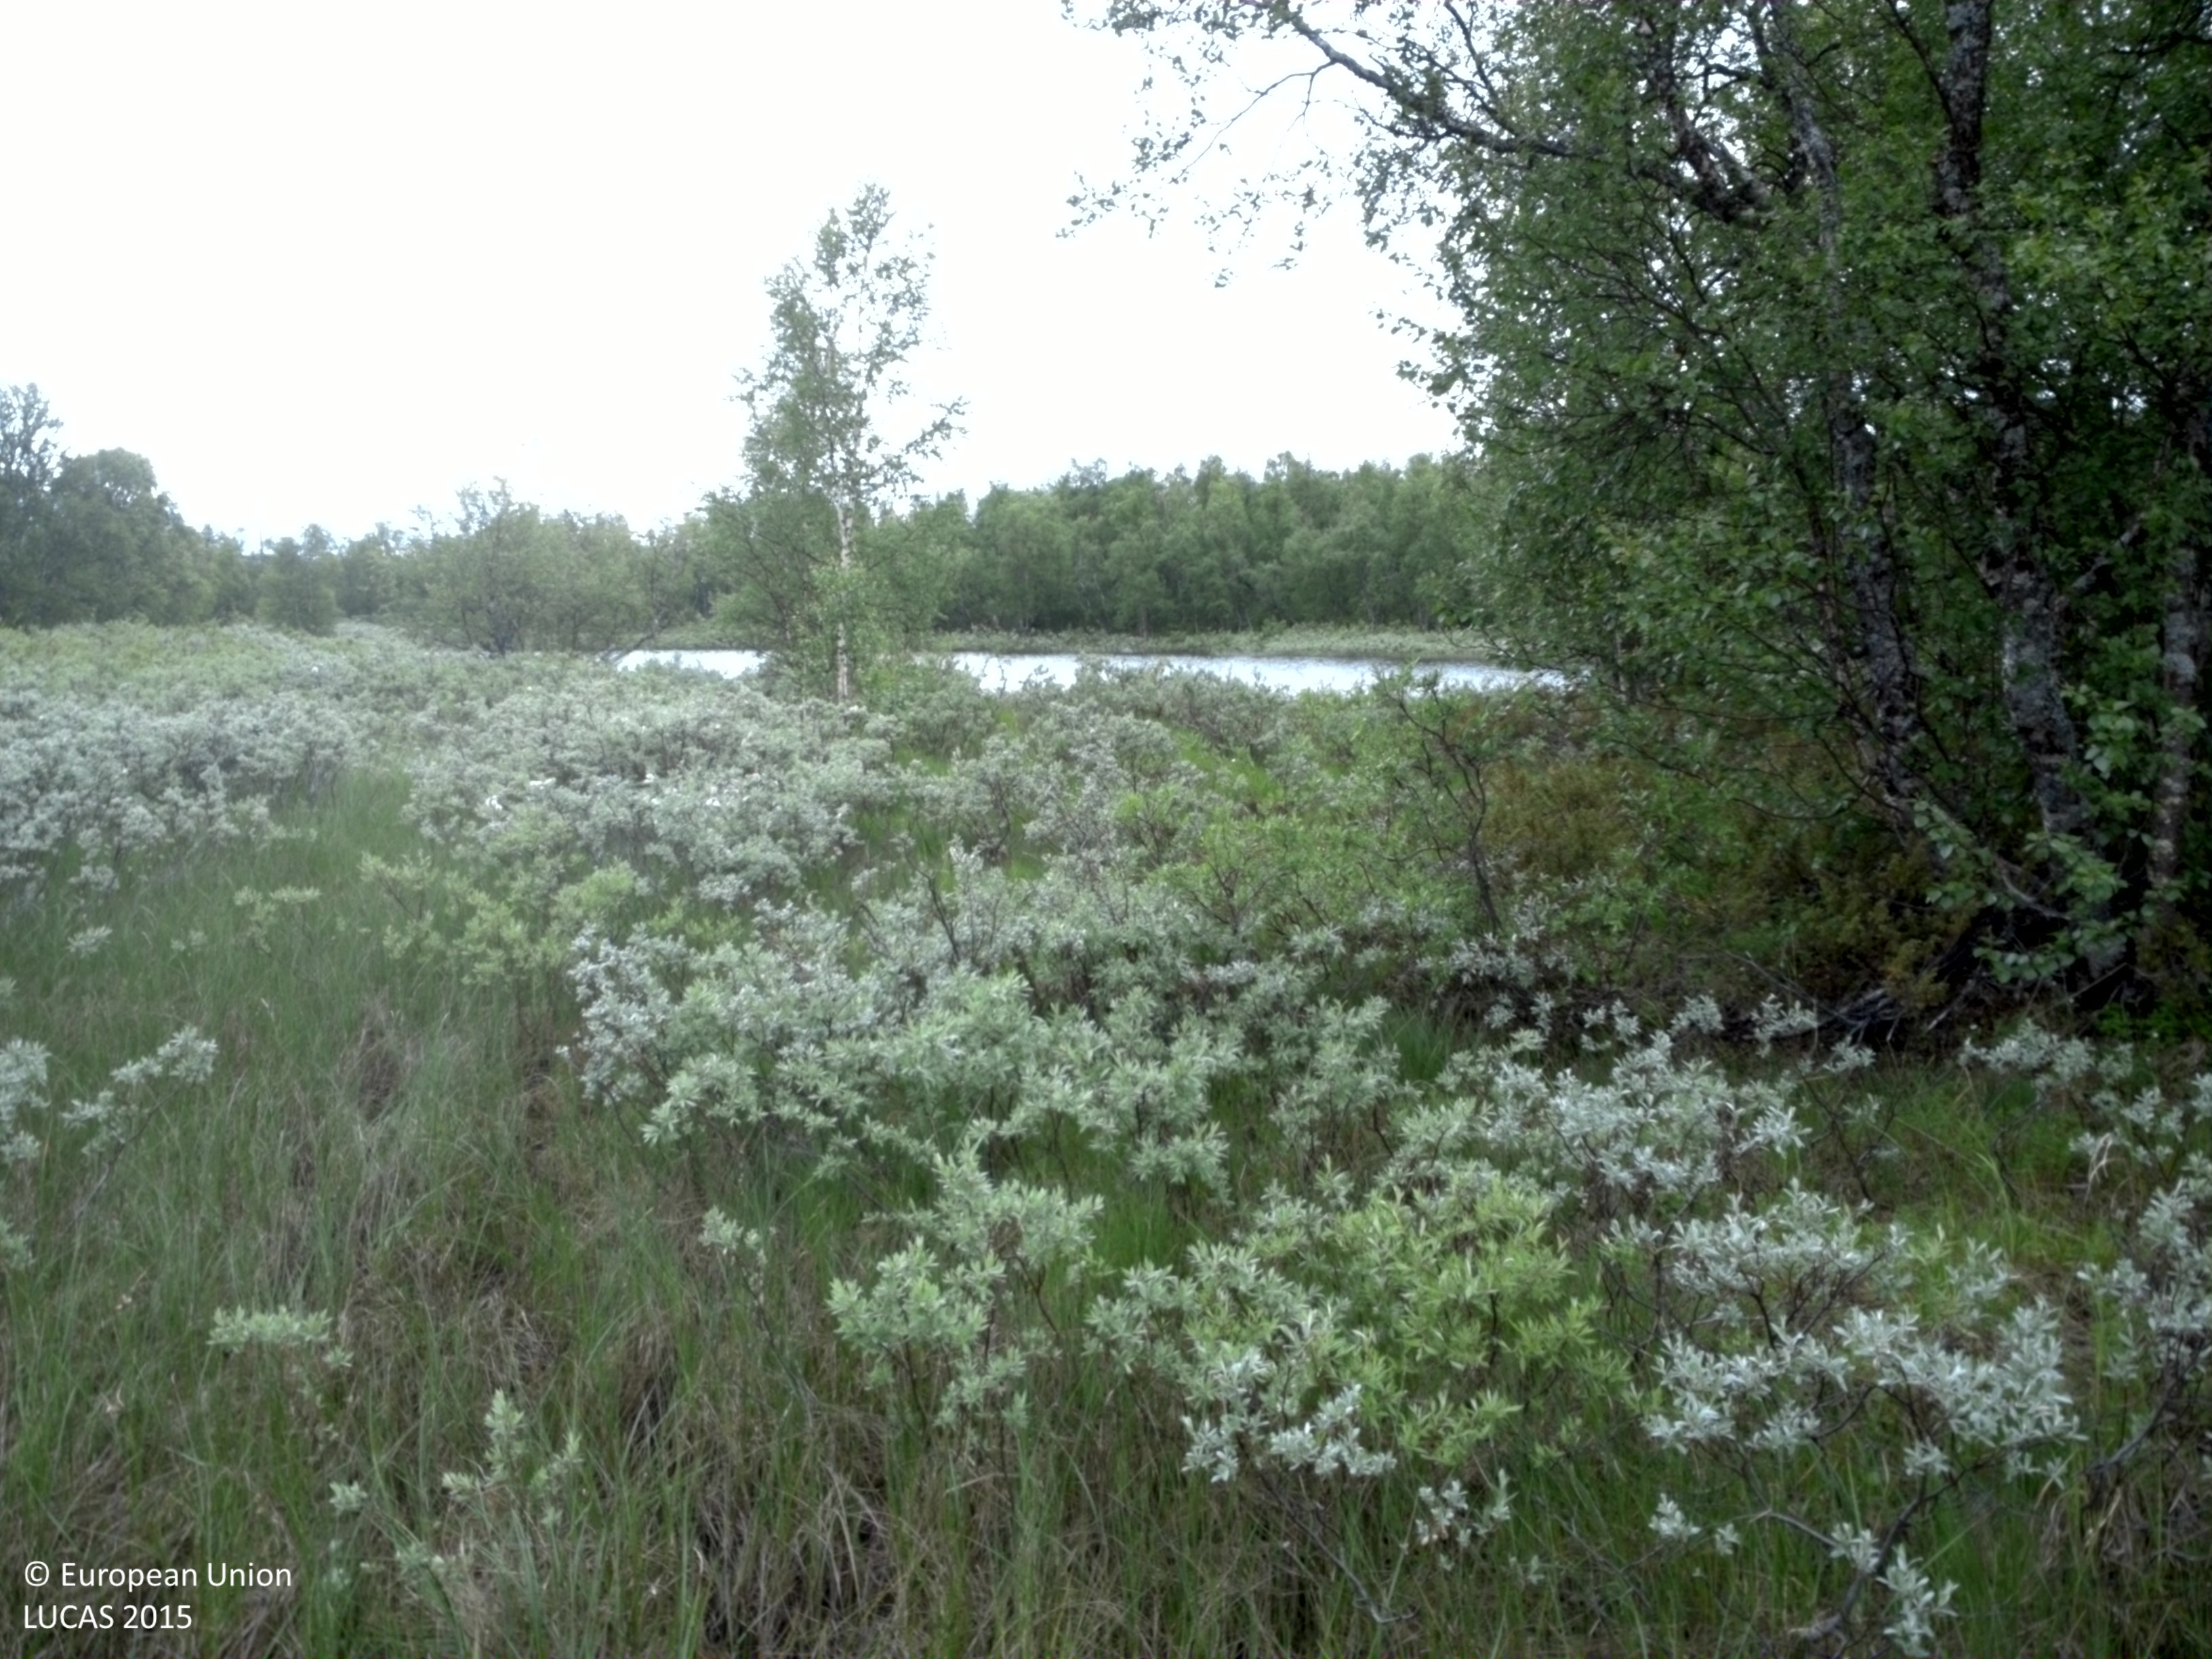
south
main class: Shrubland
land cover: Shrubland without tree cover
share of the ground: 50 - 75 %
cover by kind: shrubs 50 %, herbaceous plants 50 %
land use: Semi-natural and natural areas not in use
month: July
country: SE
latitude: 65.7636
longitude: 15.1388
